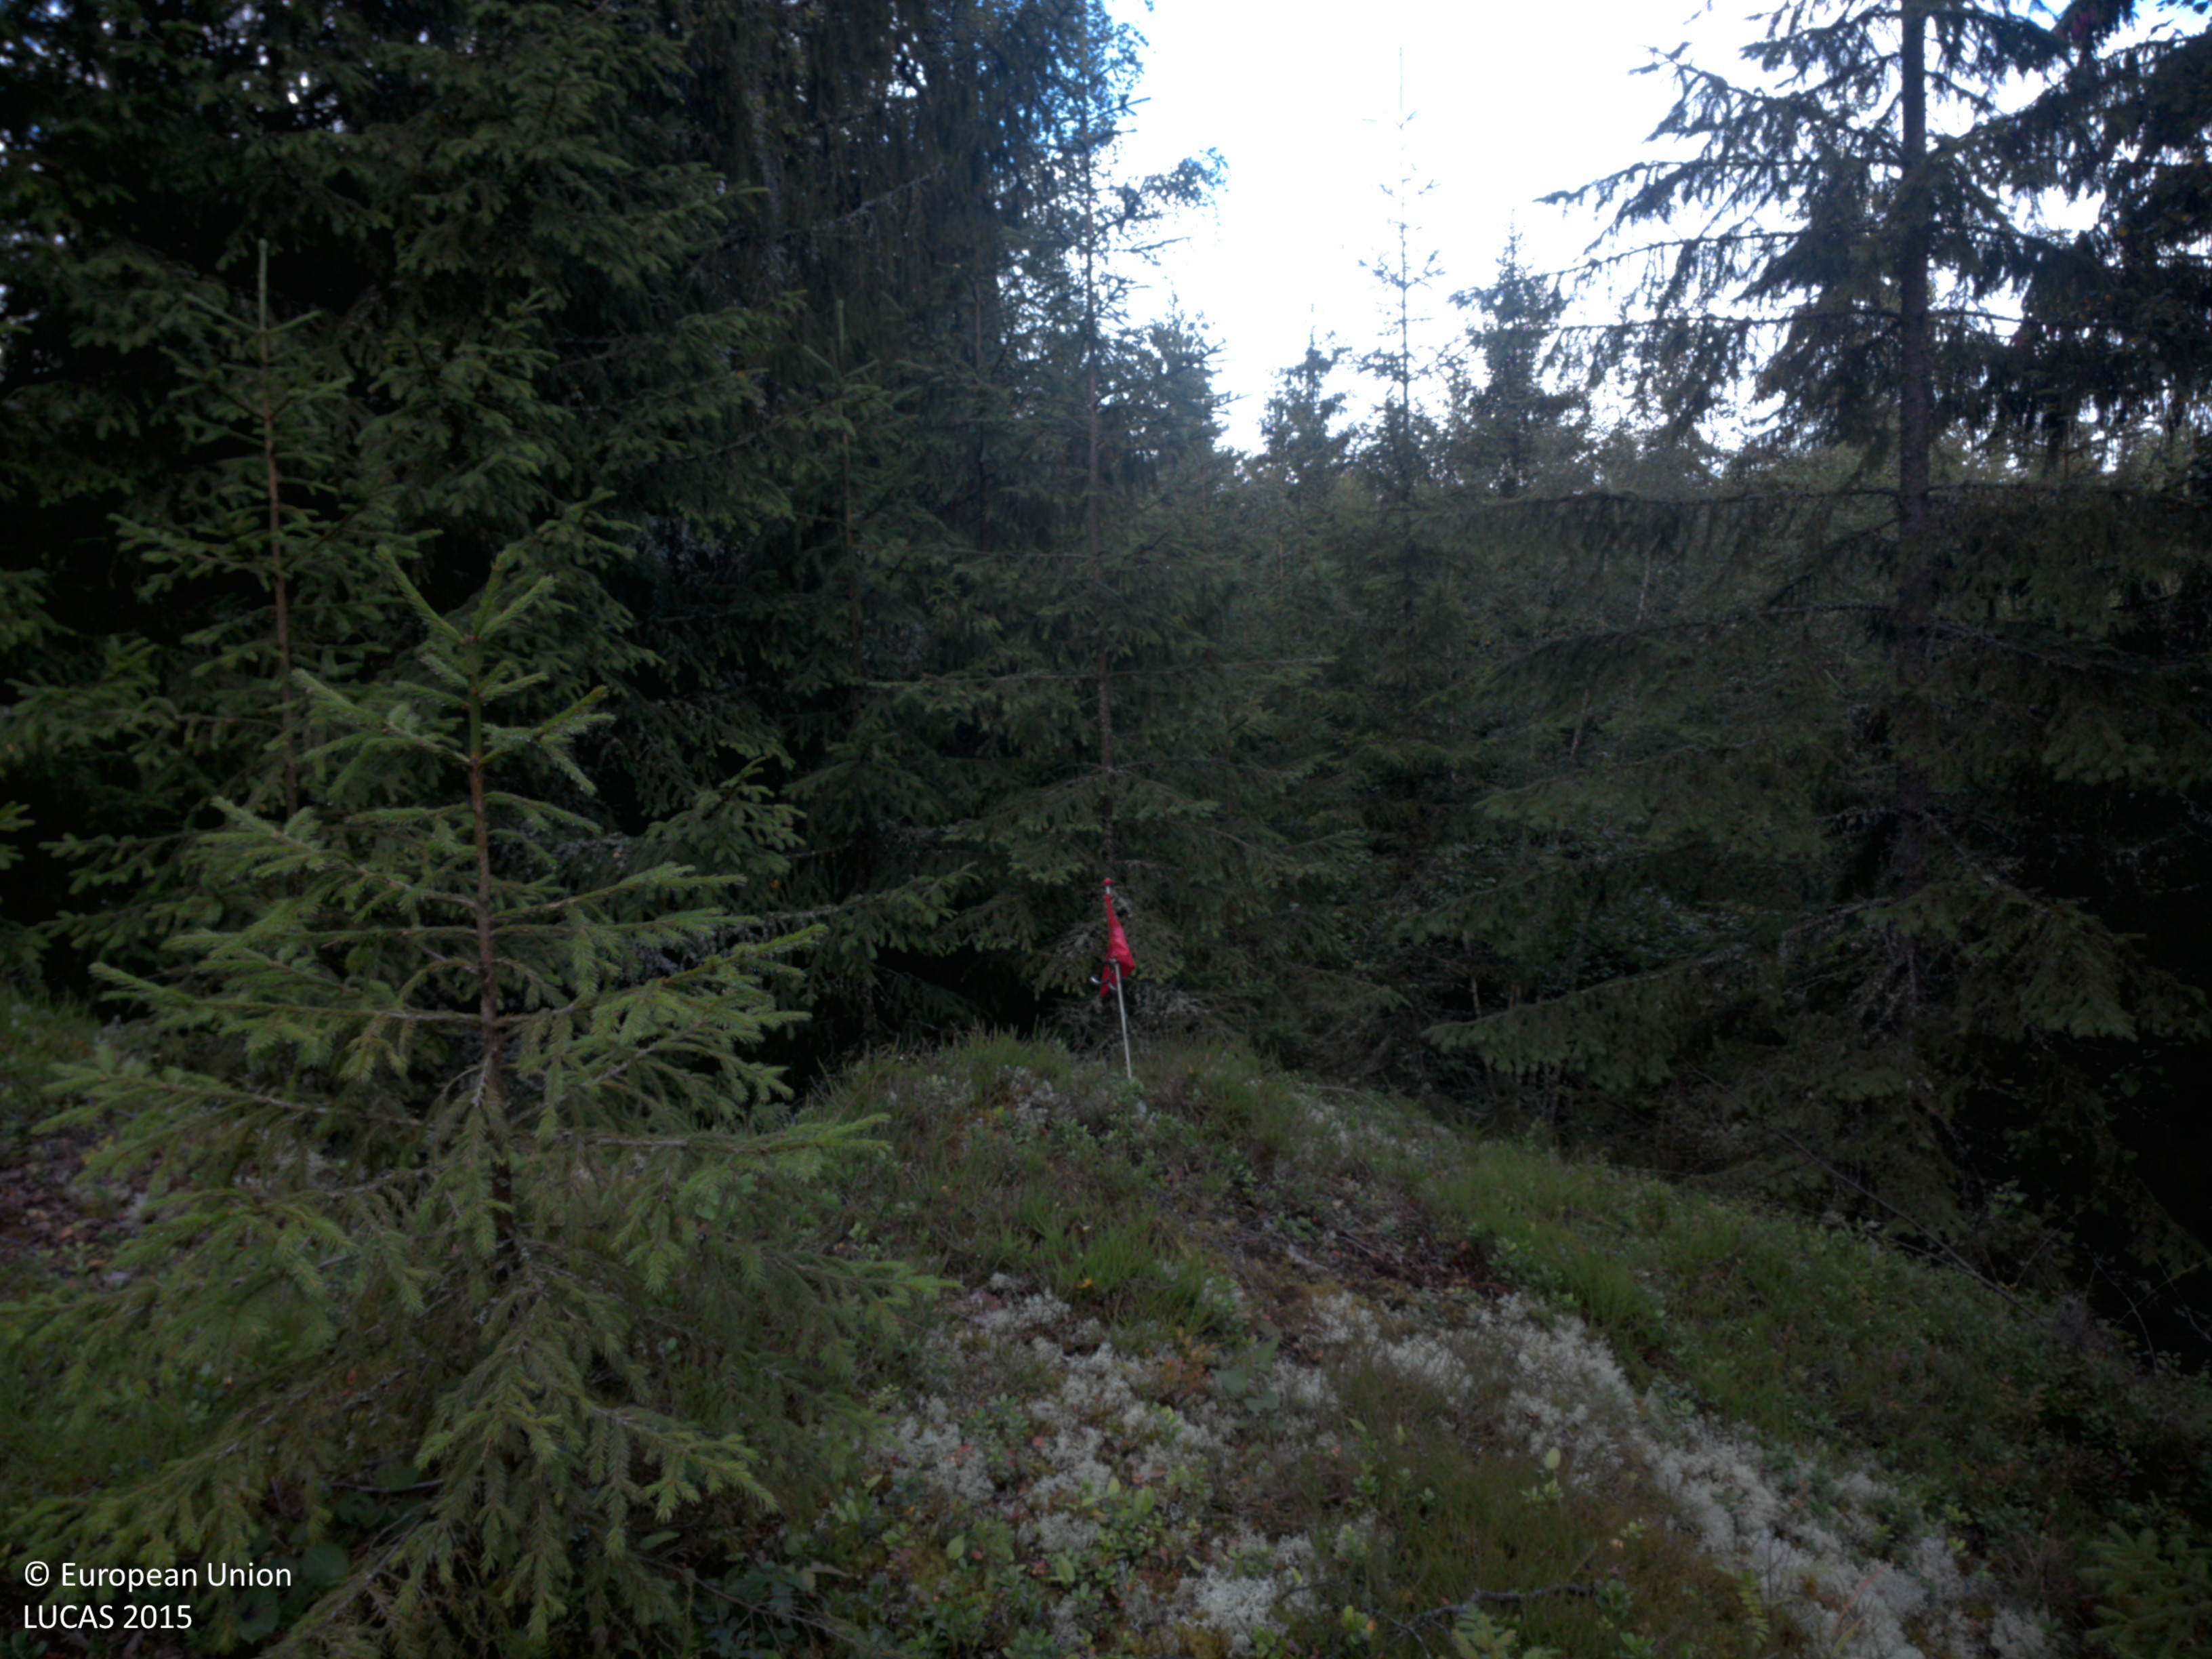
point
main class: Woodland
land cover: Spruce dominated mixed woodland
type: boreal forest
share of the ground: 50 - 75 %
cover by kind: coniferous forest trees 40 %, herbaceous plants 30 %, broadleaved forest trees 20 %, lichens and mosses 10 %
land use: Forestry
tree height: > 5 m
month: July
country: SE
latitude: 58.6373
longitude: 11.9424
